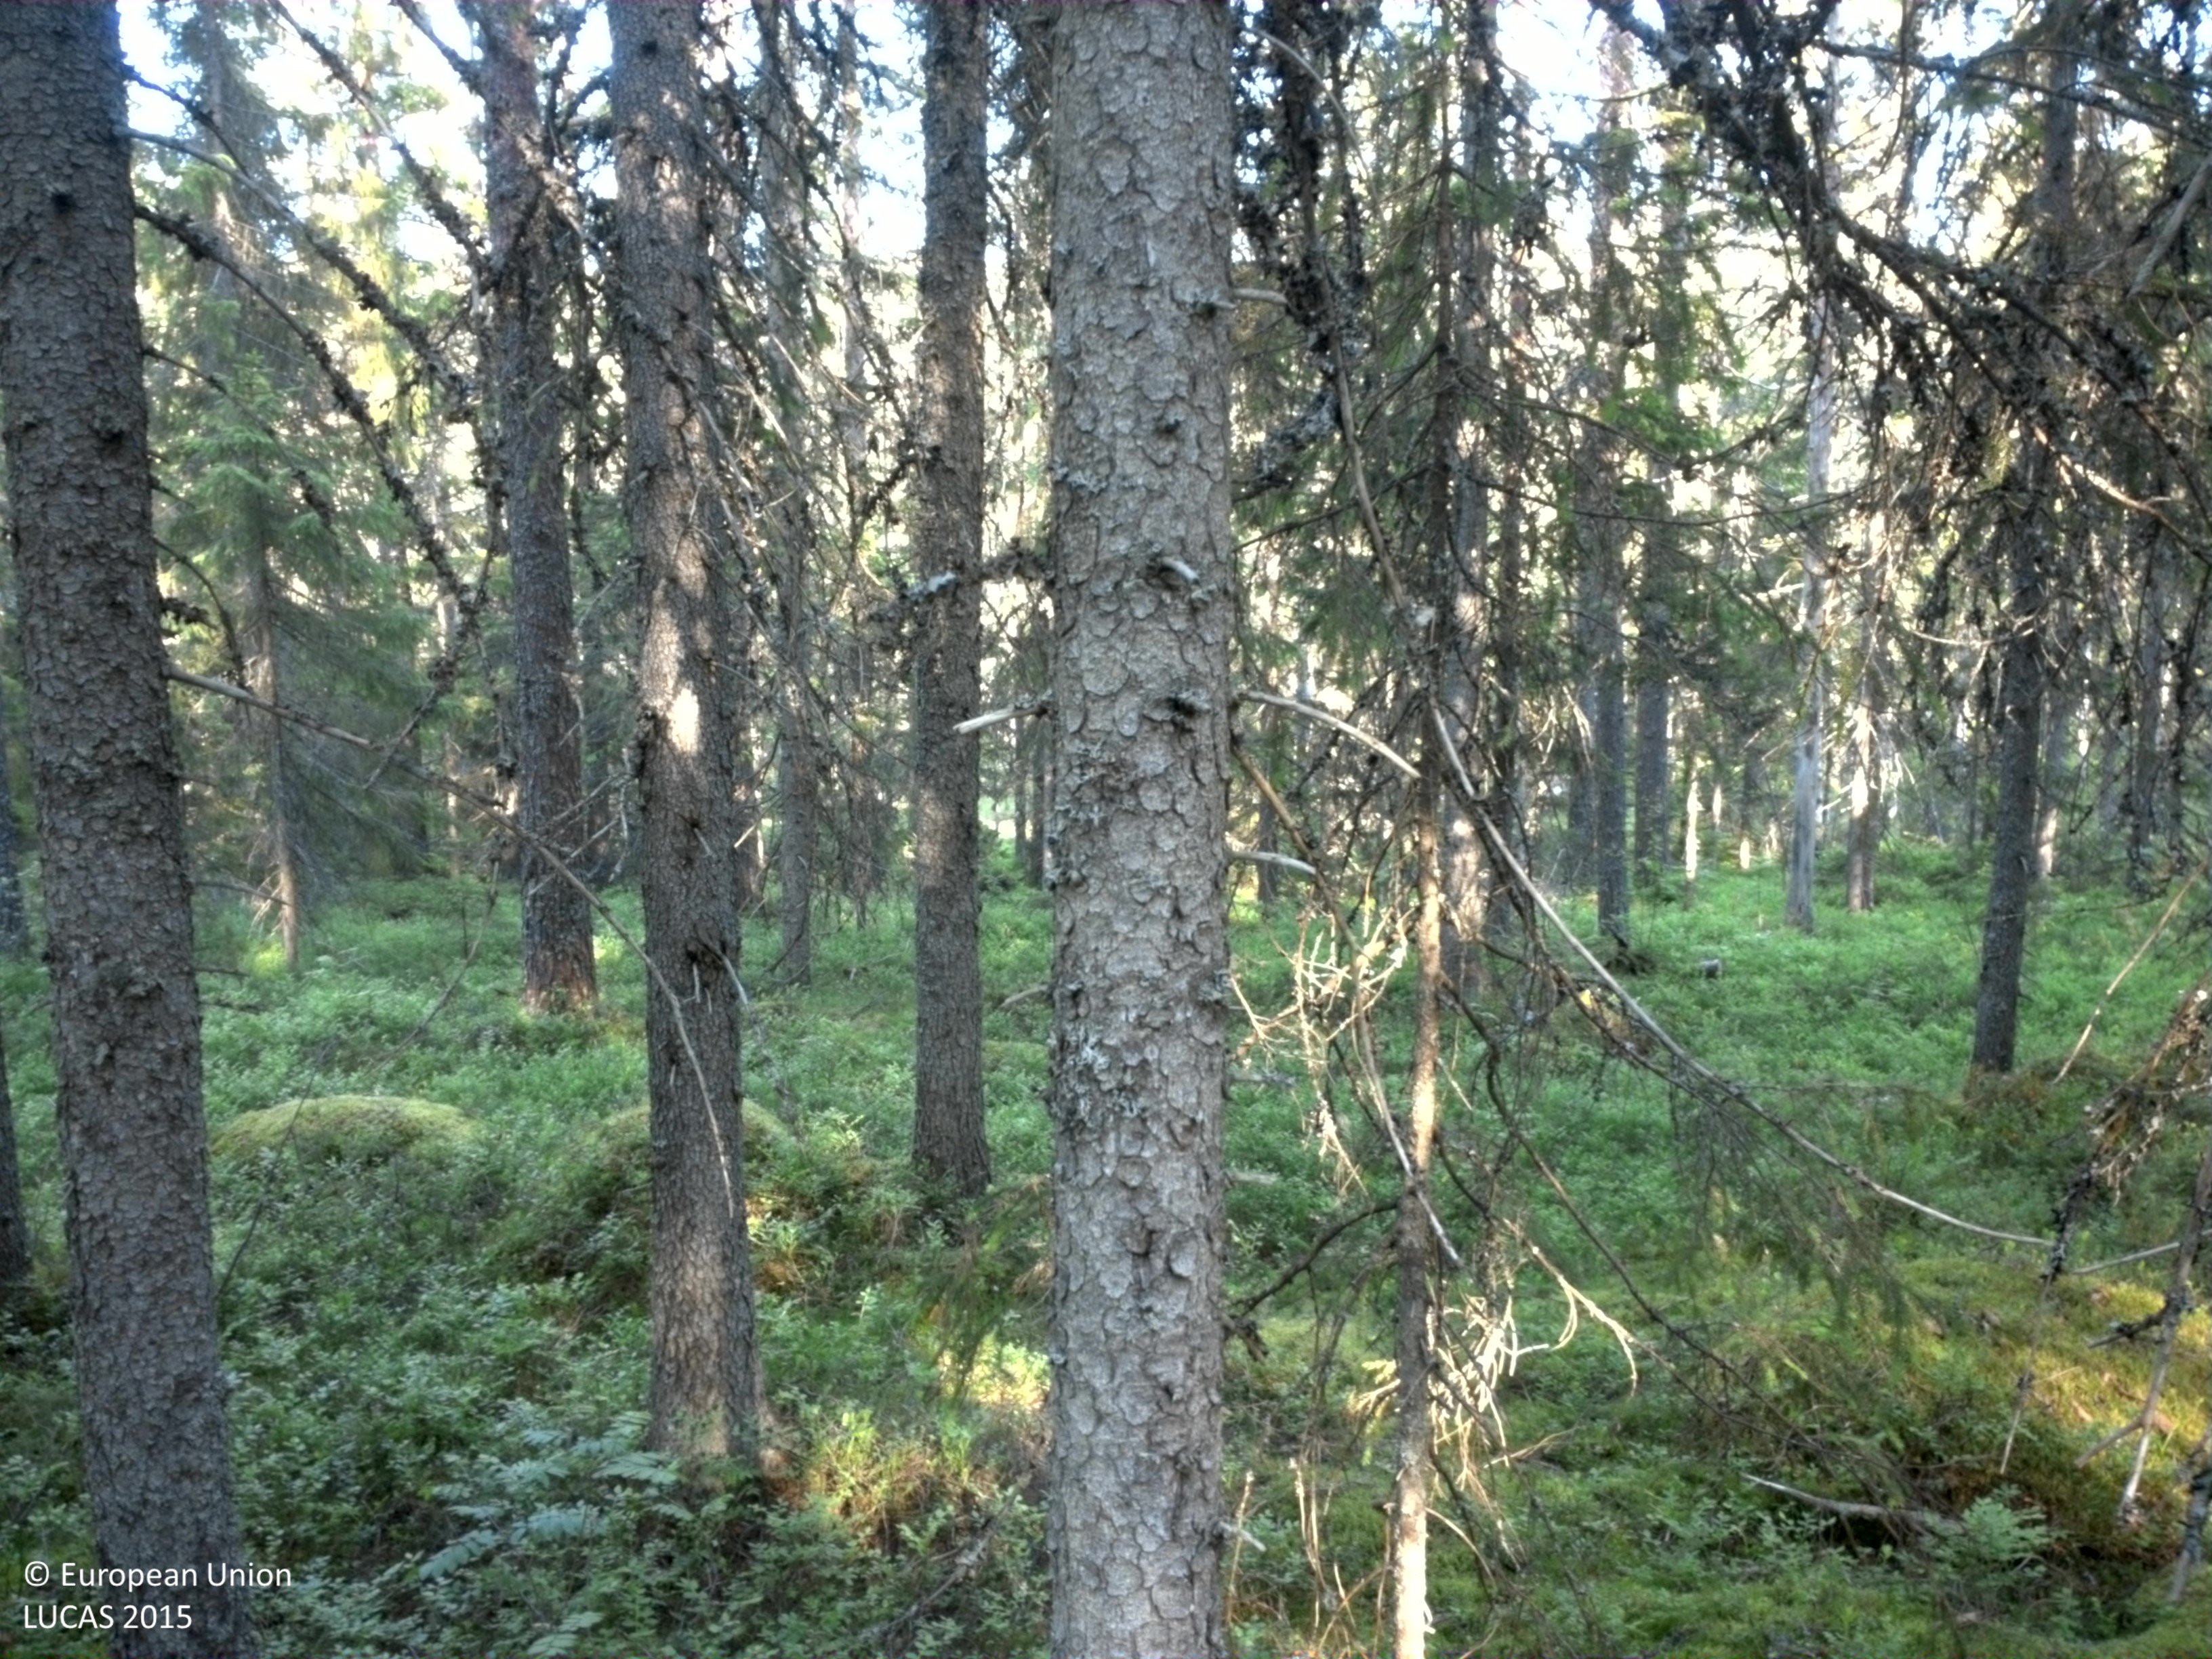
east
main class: Woodland
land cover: Spruce dominated coniferous woodland
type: boreal forest
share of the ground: 50 - 75 %
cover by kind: coniferous forest trees 75 %, shrubs 20 %, lichens and mosses 5 %
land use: Forestry
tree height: > 5 m
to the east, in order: Spruce dominated coniferous woodland; Other coniferous woodland; Pine dominated mixed woodland; Other mixed woodland; Ditches and canals; Other mixed woodland; Other coniferous woodland; Pine dominated coniferous woodland; Other mixed woodland; Pine dominated coniferous woodland
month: June
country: SE
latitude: 64.2404
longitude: 20.6428
